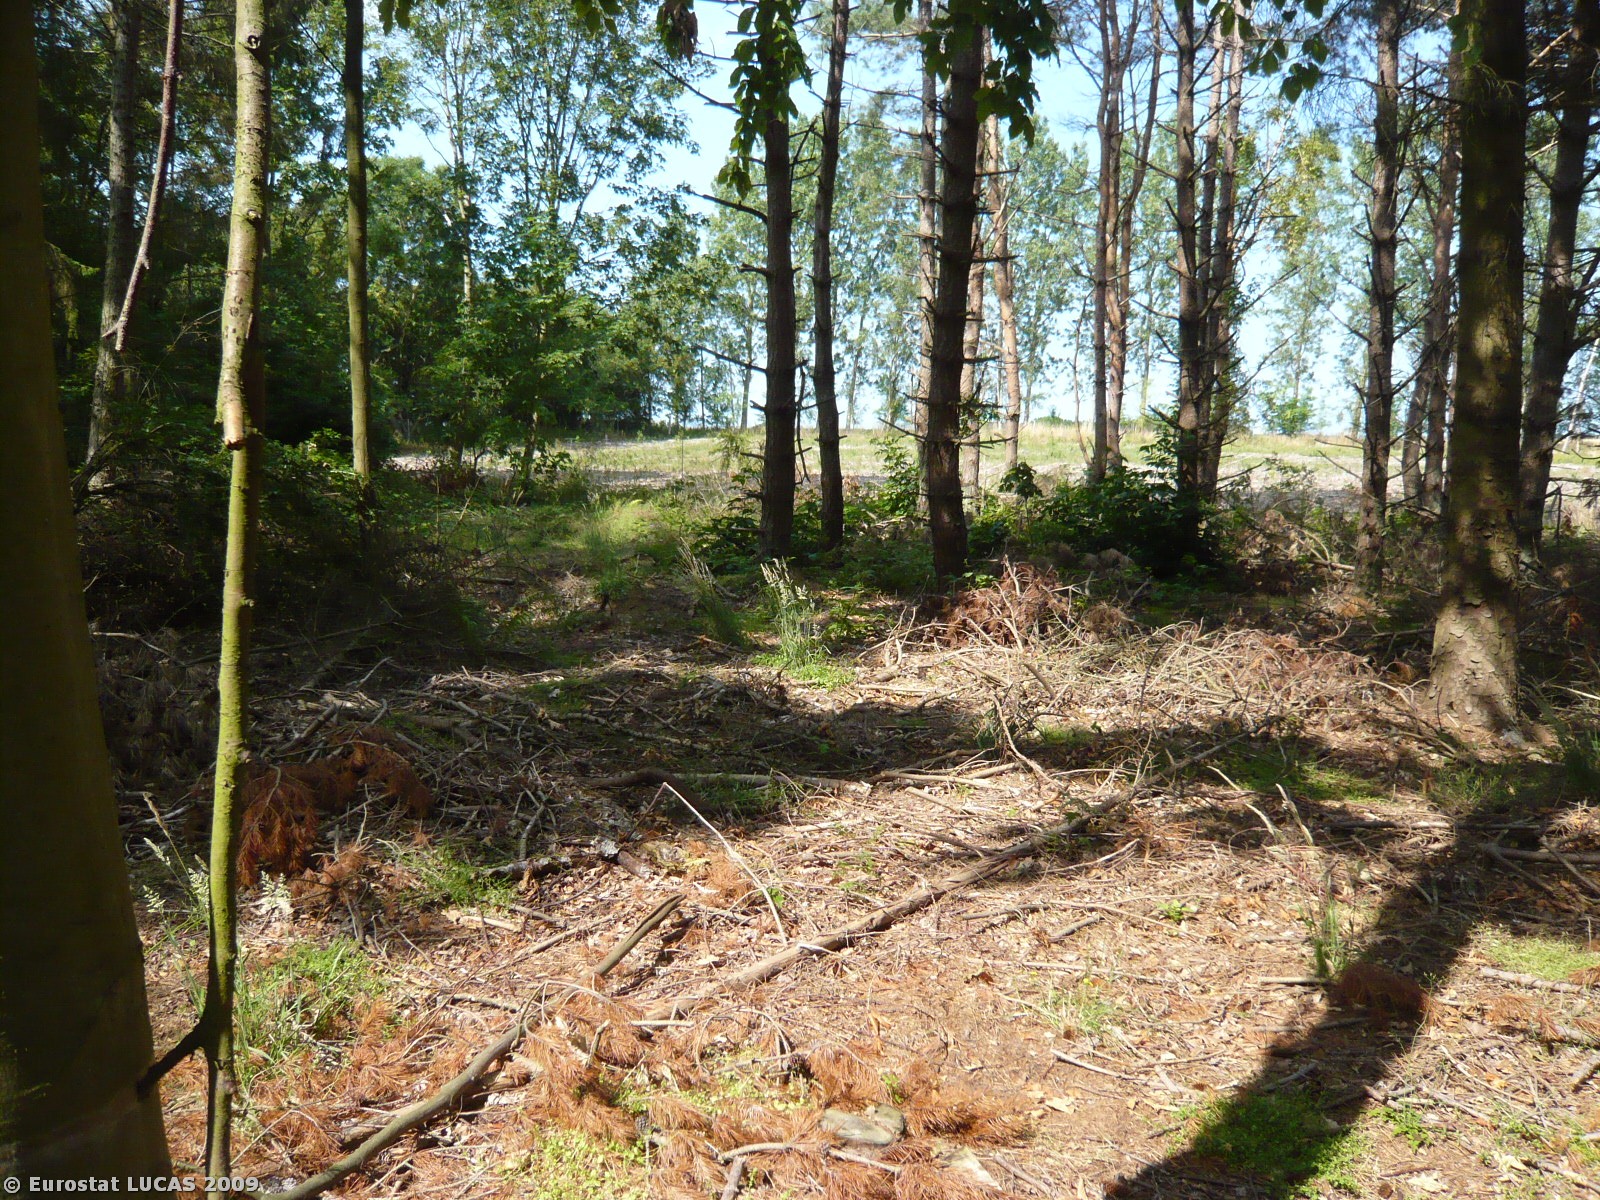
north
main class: Woodland
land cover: Coniferous woodland
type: hemiboreal forest and nemoral coniferous forest and mixed broadleaved-coniferous forest
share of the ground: > 75 %
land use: Forestry
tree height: > 5 m
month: July
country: DK
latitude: 55.9242
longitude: 11.7426
